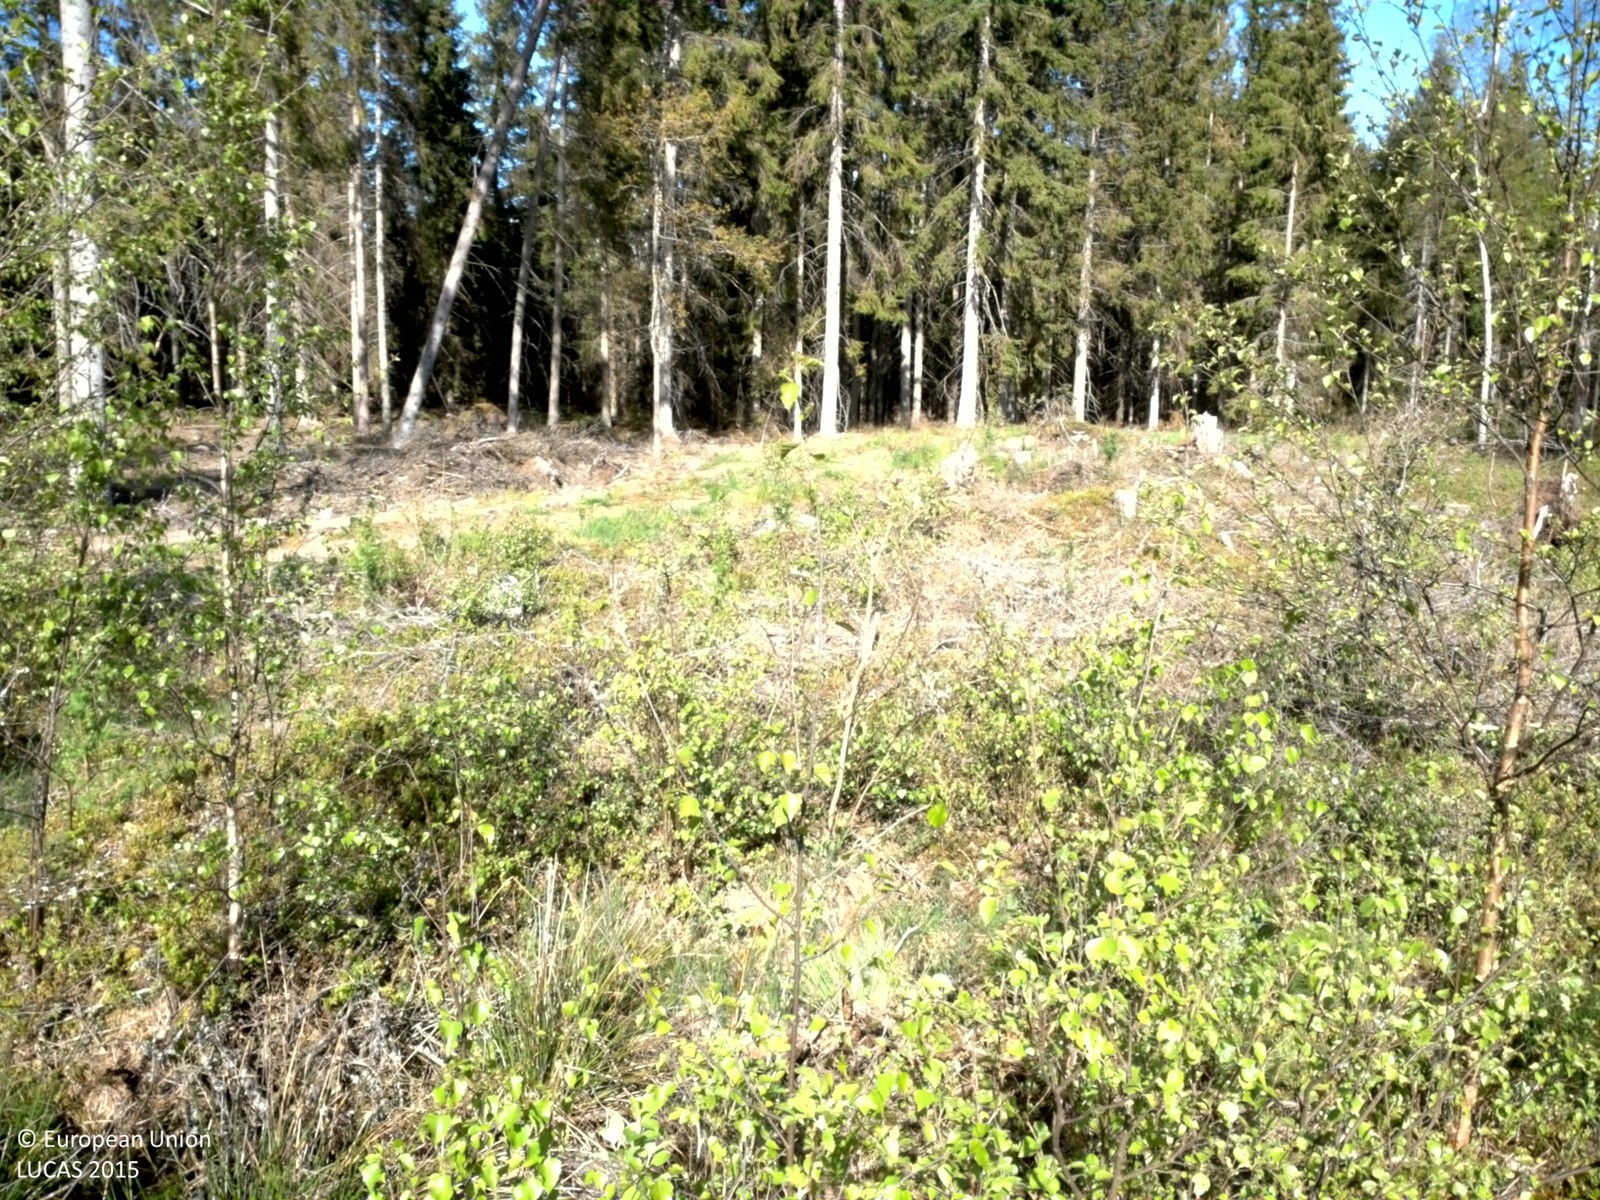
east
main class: Woodland
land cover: Broadleaved woodland
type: boreal forest
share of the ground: > 75 %
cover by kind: broadleaved forest trees 70 %, herbaceous plants 20 %, coniferous forest trees 5 %, shrubs 5 %
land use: Forestry
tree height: < 5 m
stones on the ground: < 10 %
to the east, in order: Broadleaved woodland; Tracks; Spruce dominated coniferous woodland; Tracks; Spruce dominated coniferous woodland; Spruce dominated mixed woodland; Tracks; Shrubland with sparse tree cover; Spruce dominated mixed woodland
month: May
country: SE
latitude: 56.5780
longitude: 15.4195
